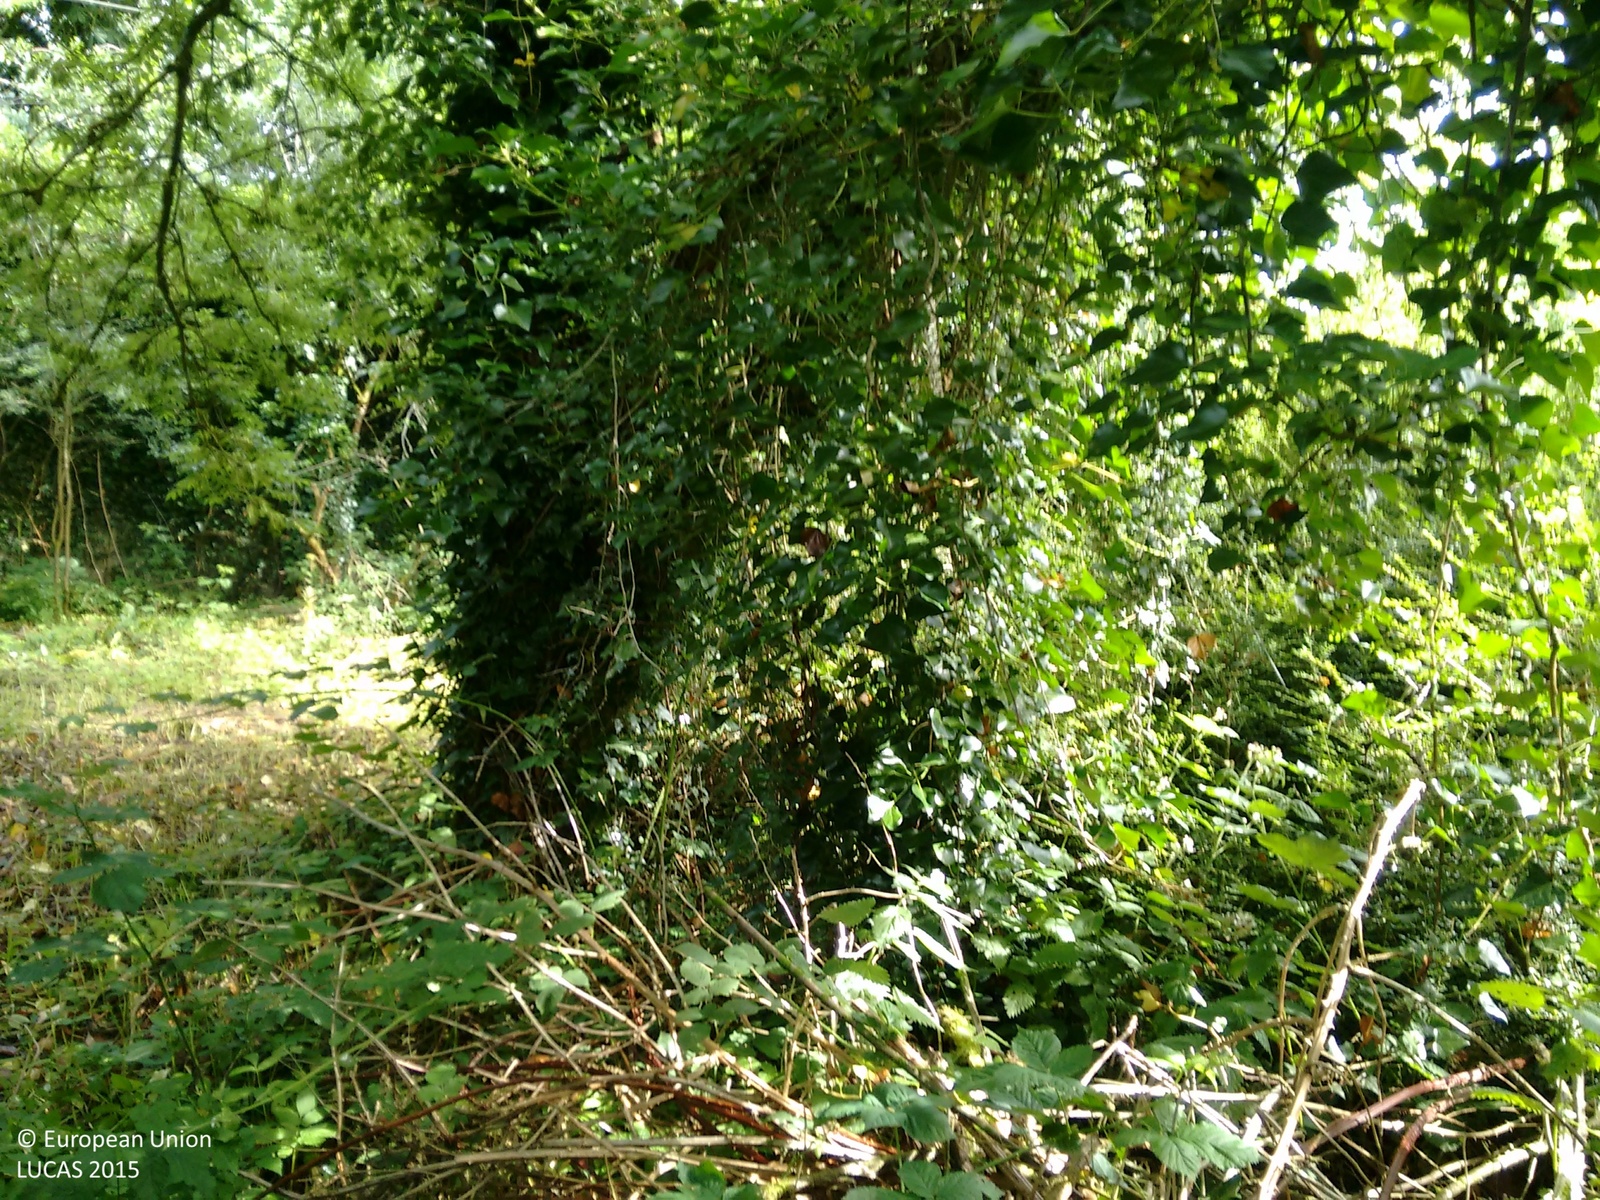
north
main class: Woodland
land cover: Broadleaved woodland
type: acidophilous oak and oak-birch forest
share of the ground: > 75 %
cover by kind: broadleaved forest trees 95 %, shrubs 5 %
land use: Semi-natural and natural areas not in use
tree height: > 5 m
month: July
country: IE
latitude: 52.7299
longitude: -7.4380
